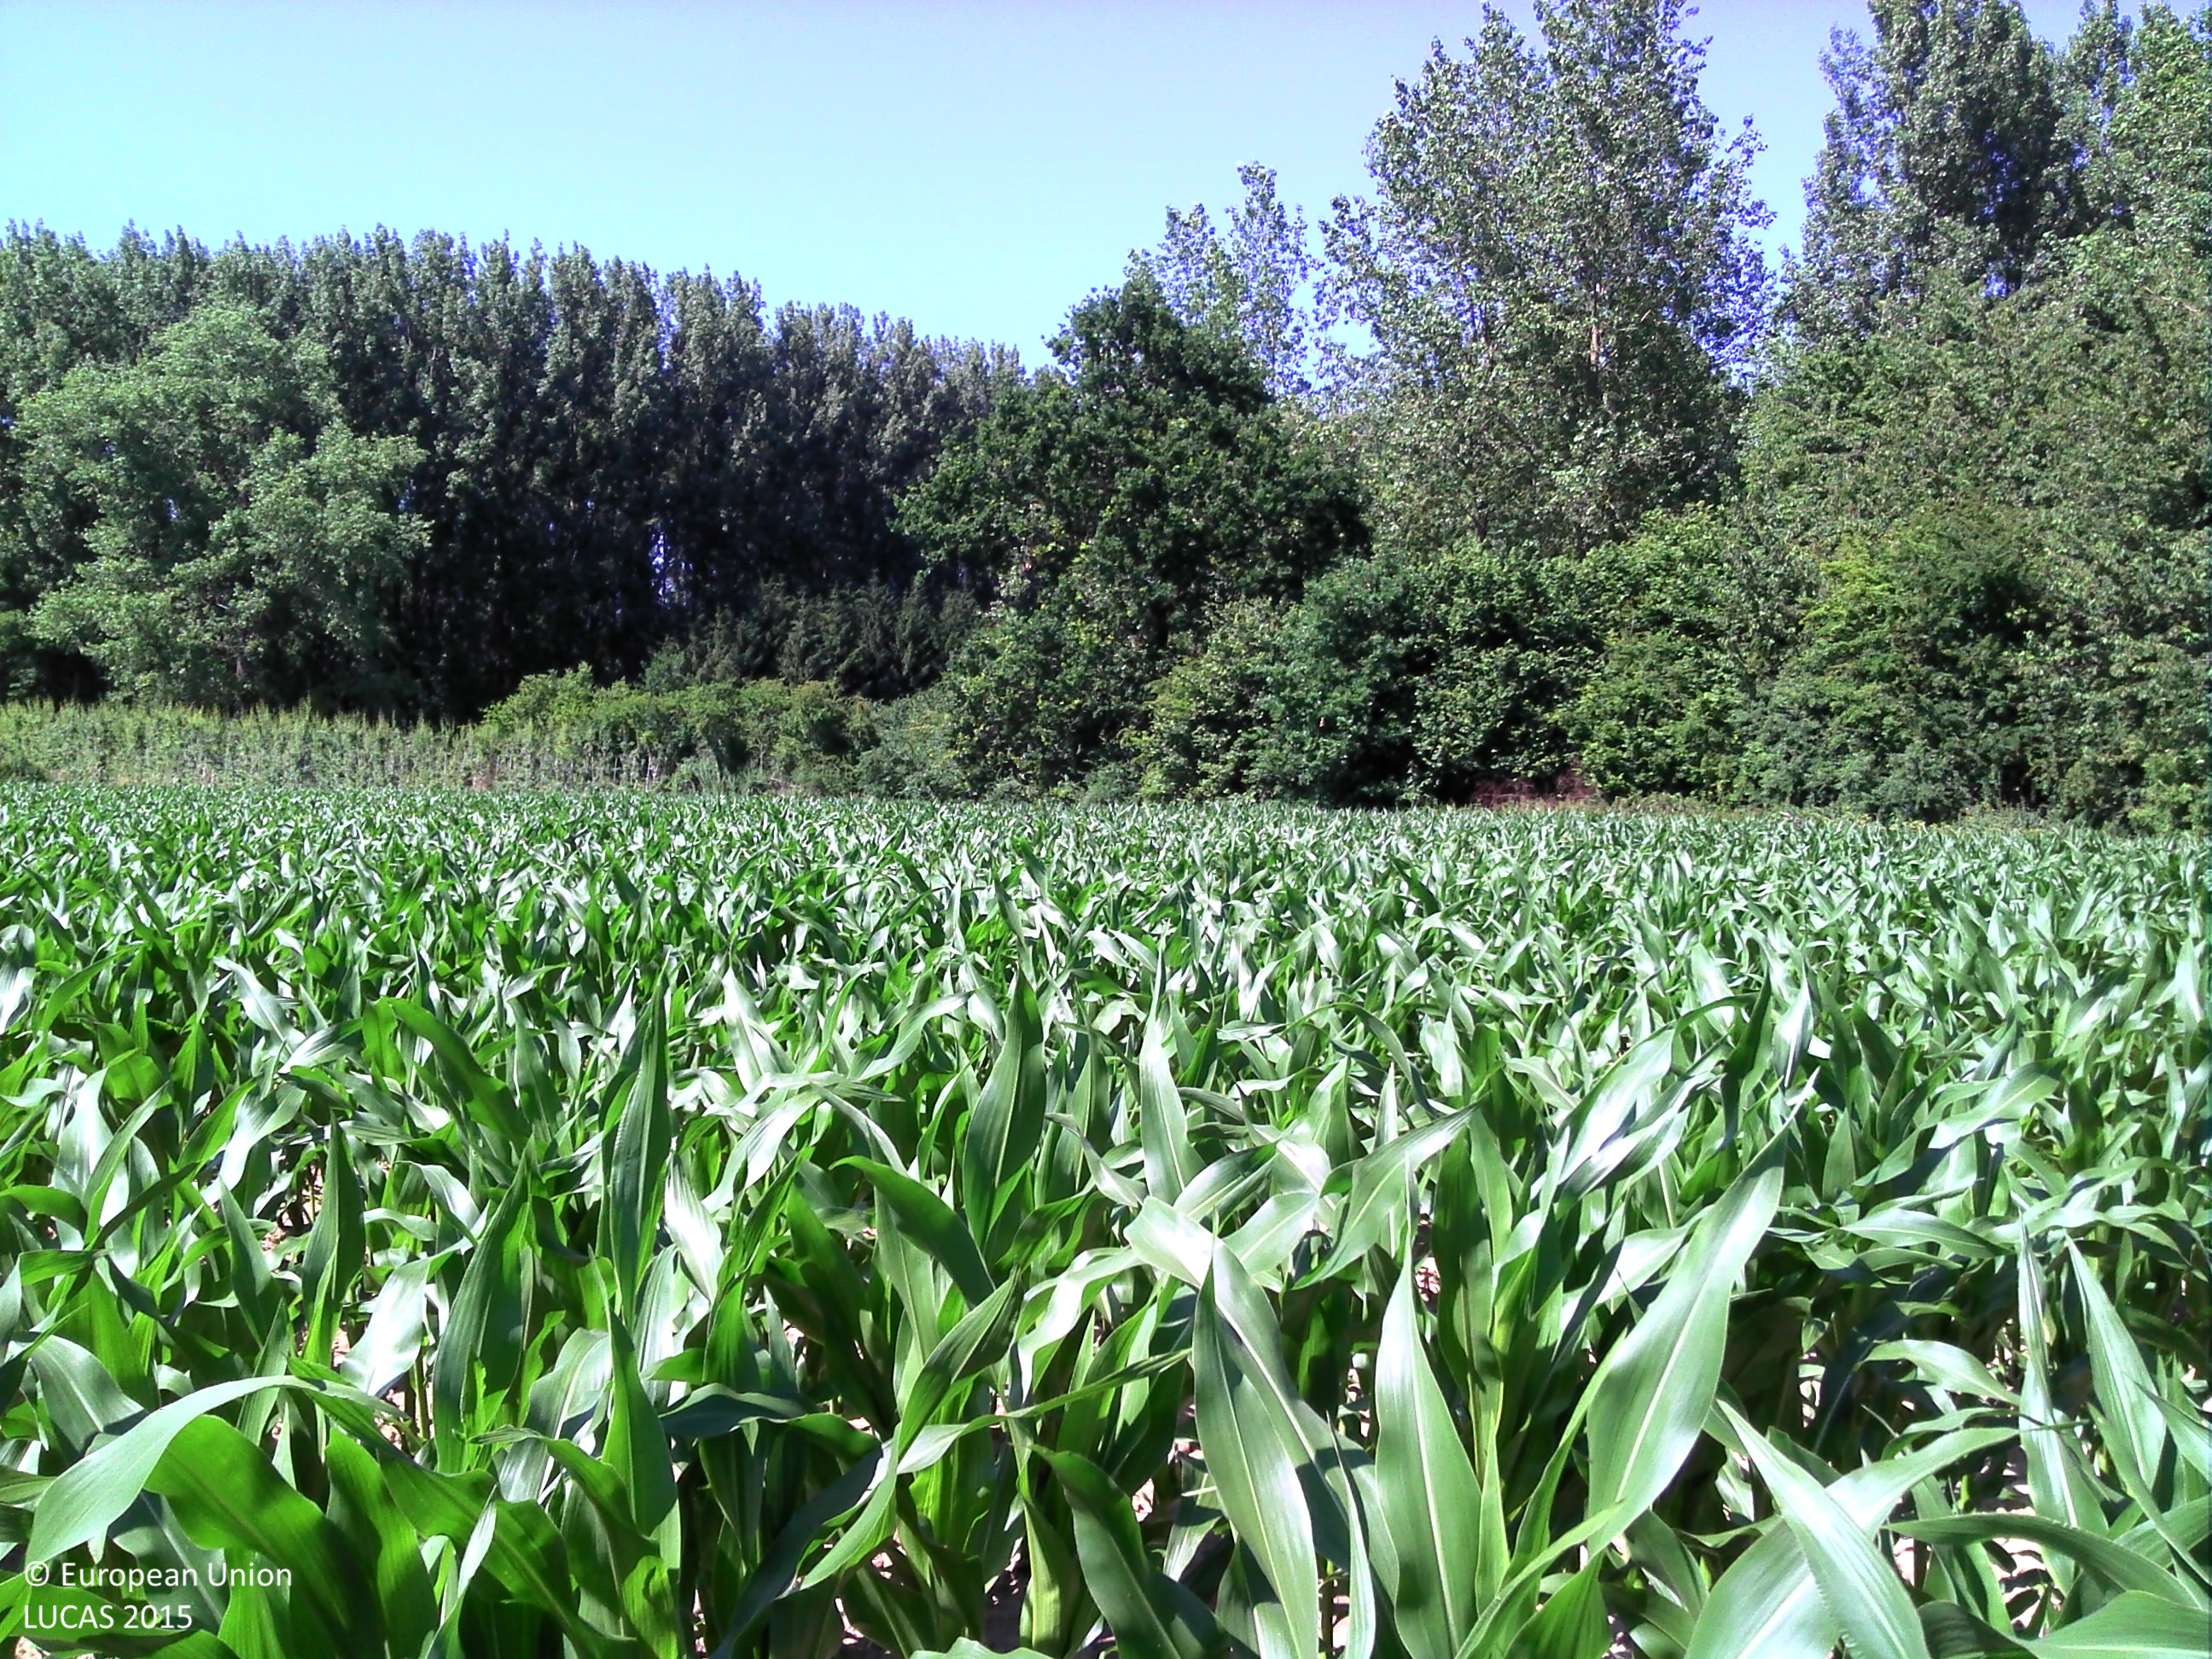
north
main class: Cropland
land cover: Maize
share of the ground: > 75 %
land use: Agriculture (excluding fallow land and kitchen gardens)
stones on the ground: < 10 %
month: June
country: BE
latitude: 50.8426
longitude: 5.2686
